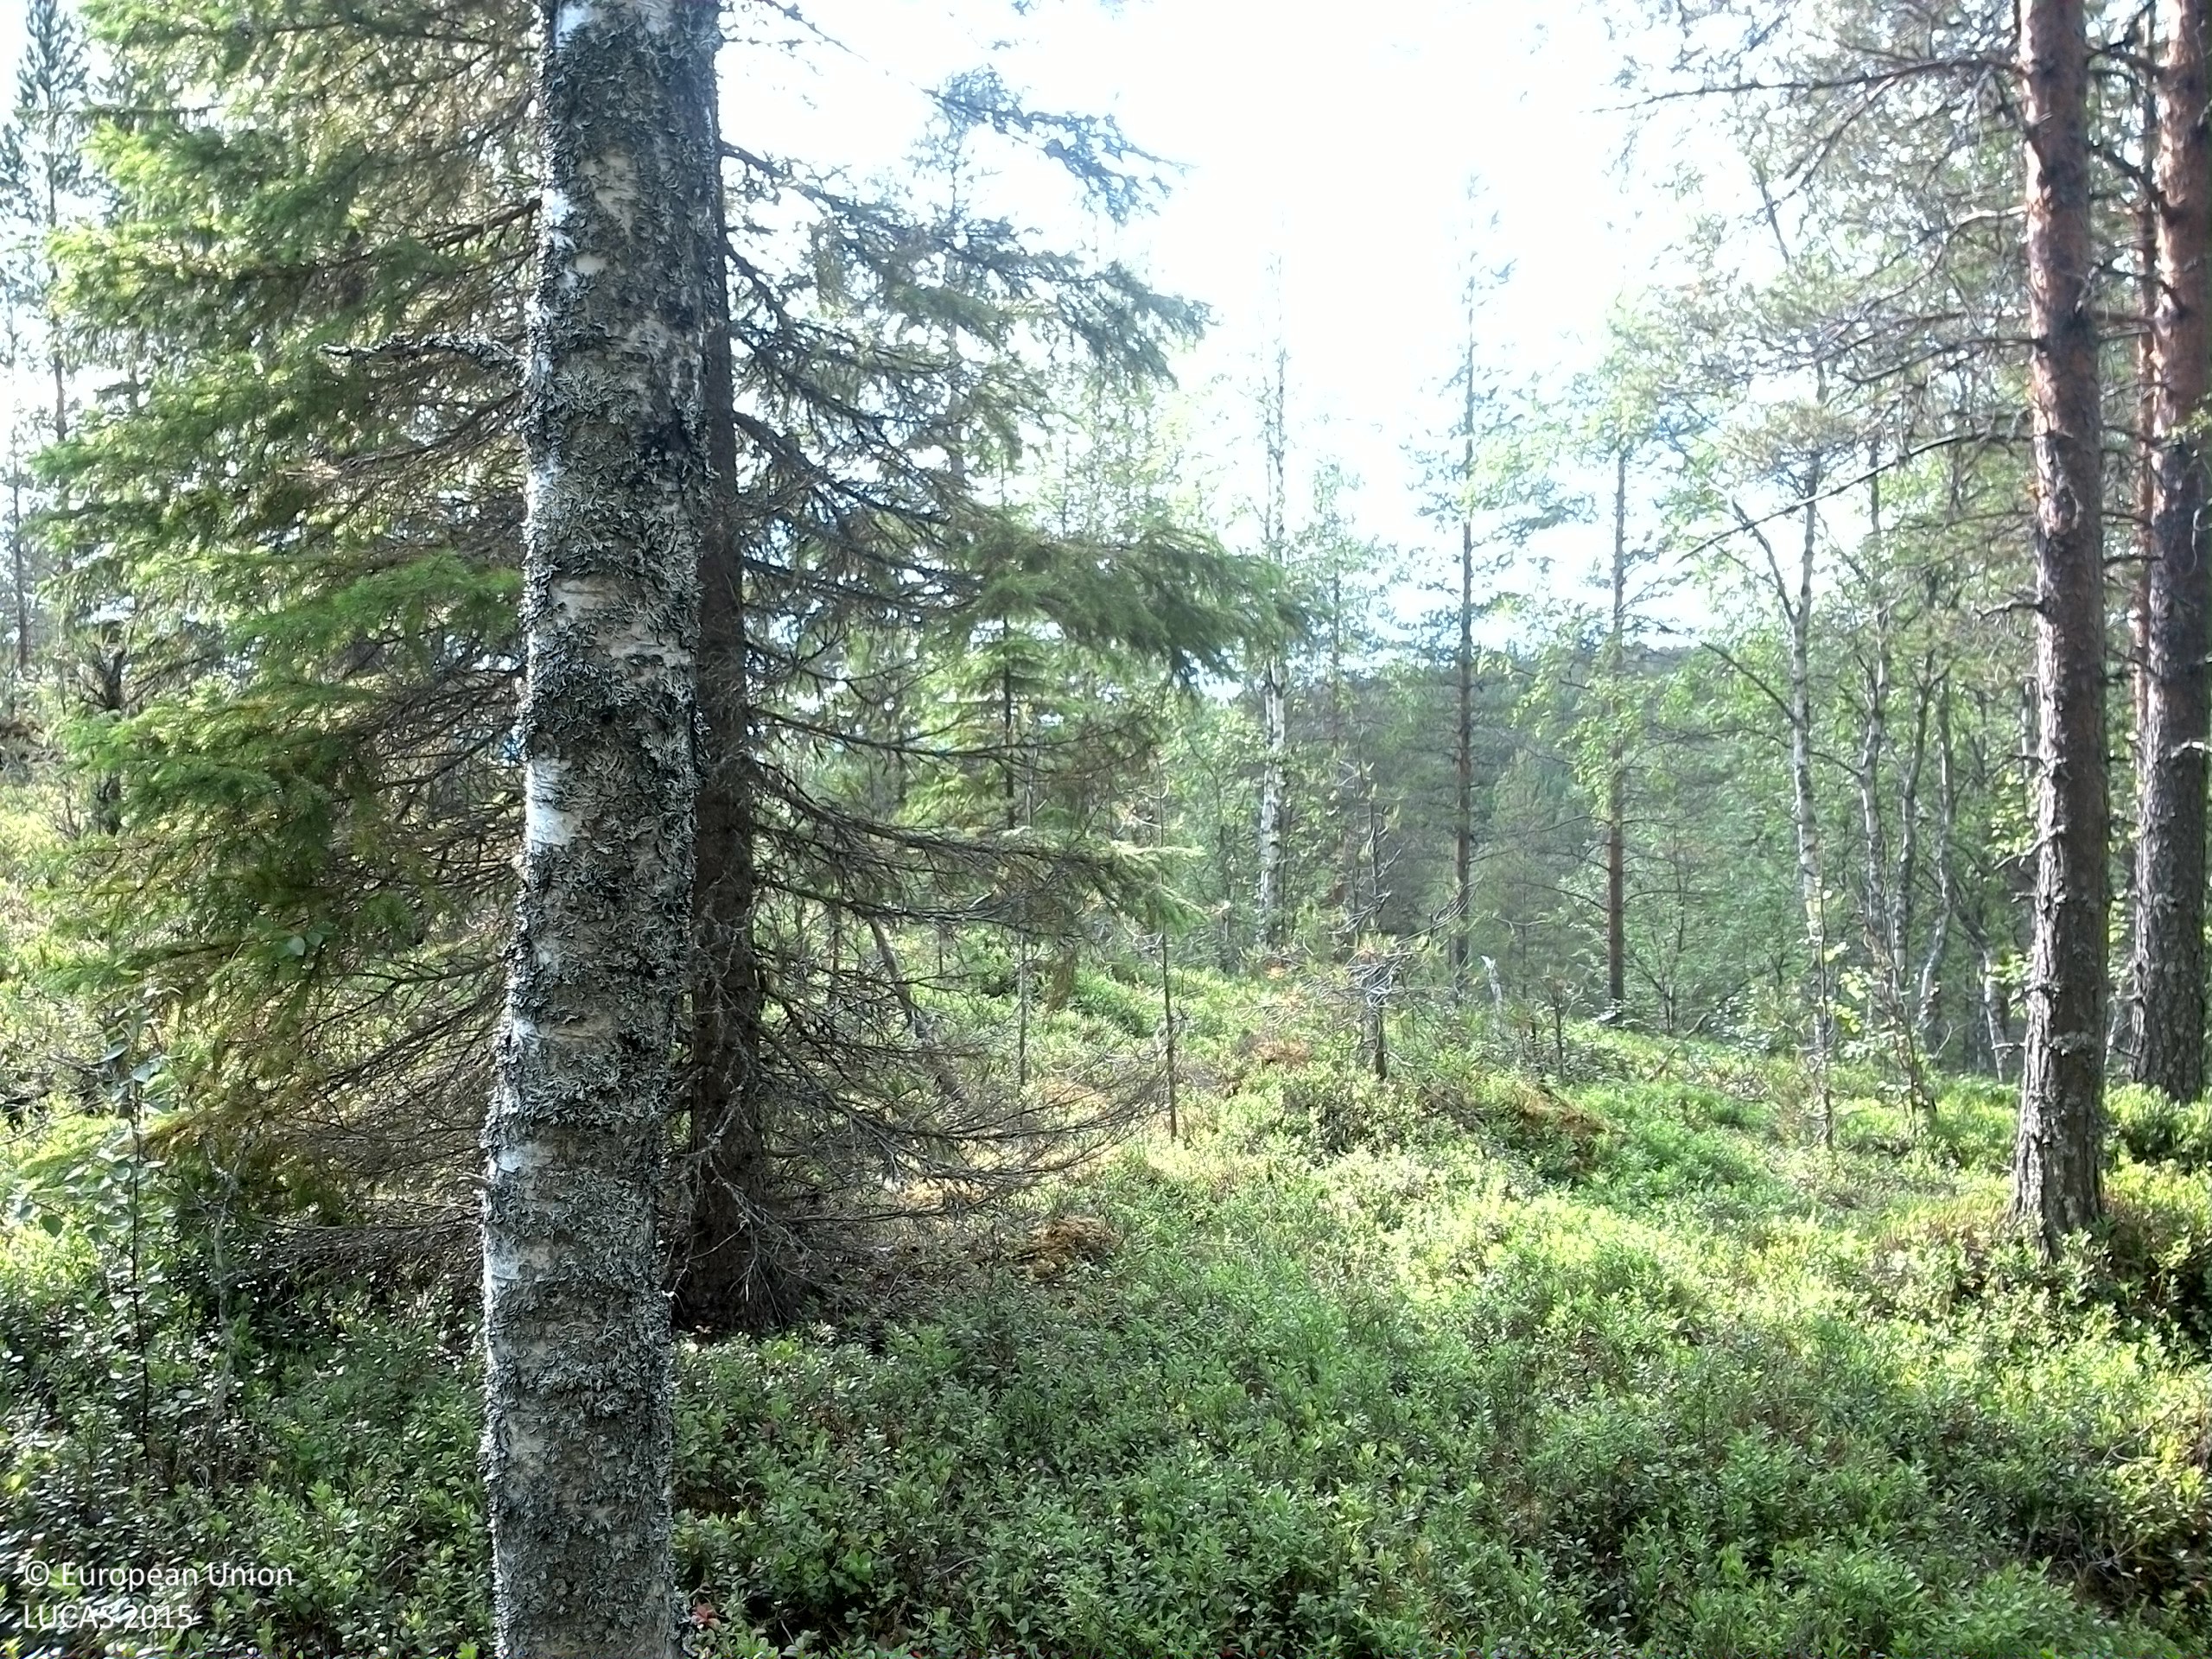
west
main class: Woodland
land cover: Pine dominated mixed woodland
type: boreal forest
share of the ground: 50 - 75 %
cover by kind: coniferous forest trees 45 %, shrubs 30 %, broadleaved forest trees 15 %, lichens and mosses 10 %
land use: Forestry
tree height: > 5 m
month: July
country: SE
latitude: 63.5401
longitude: 17.3159
